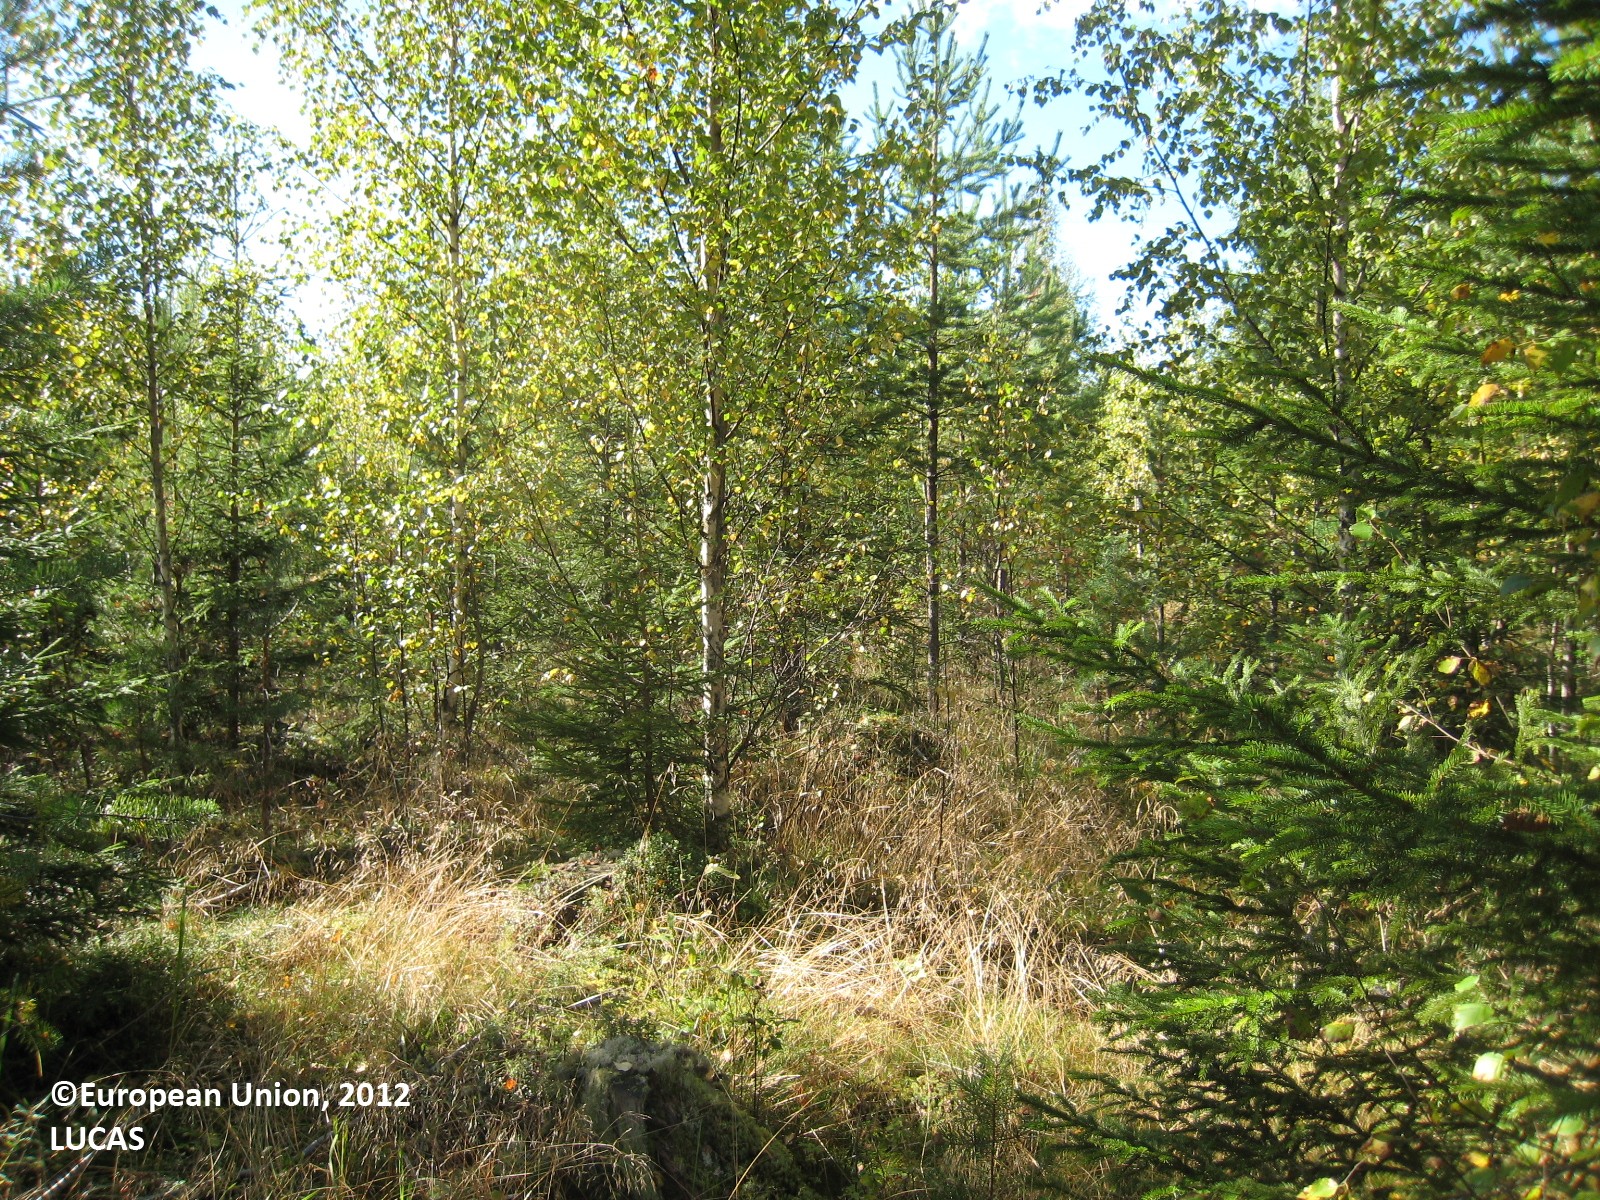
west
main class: Woodland
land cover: Other mixed woodland
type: boreal forest
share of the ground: > 75 %
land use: Forestry
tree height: > 5 m
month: September
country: FI
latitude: 63.0068
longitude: 26.8287
